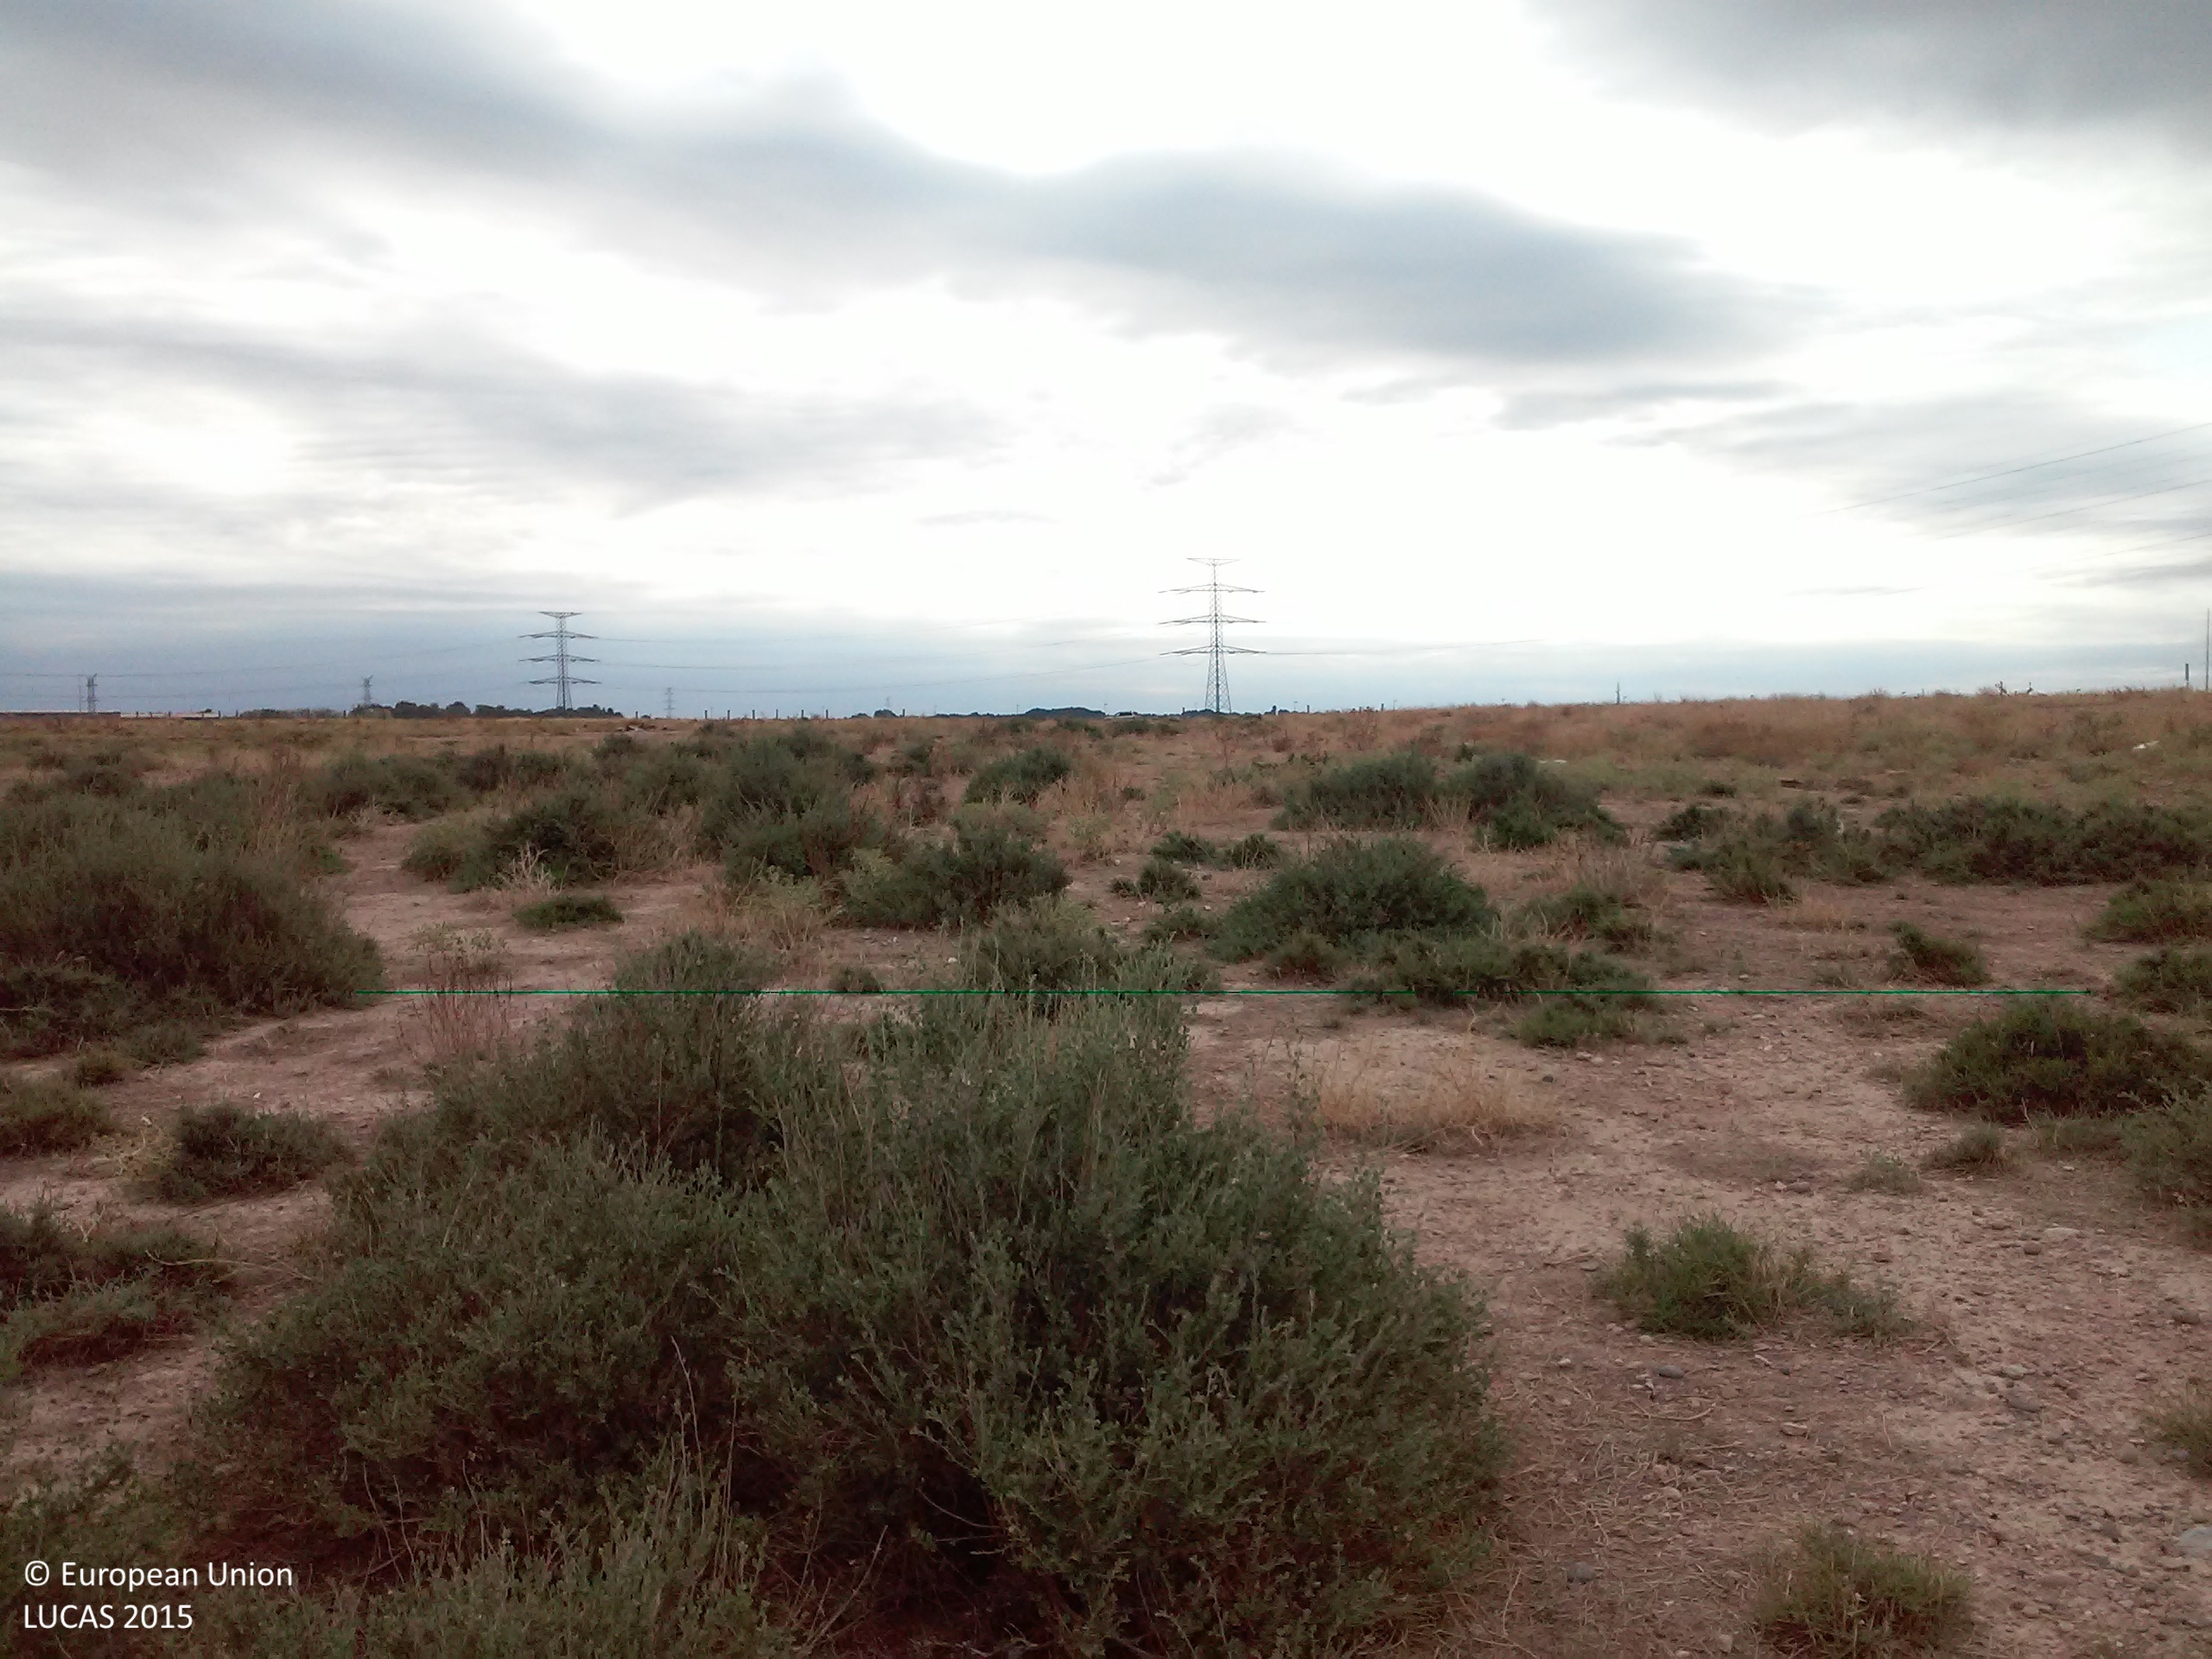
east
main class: Grassland
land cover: Grassland without tree/shrub cover
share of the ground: > 75 %
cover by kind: herbaceous plants 60 %, consolidated bare surface 35 %, shrubs 5 %
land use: Residential
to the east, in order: Grassland without tree/shrub cover; Tracks; Grassland without tree/shrub cover; Other bare soil; Tracks; Grass margins; Tracks
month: July
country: ES
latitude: 41.6041
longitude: 0.6650
